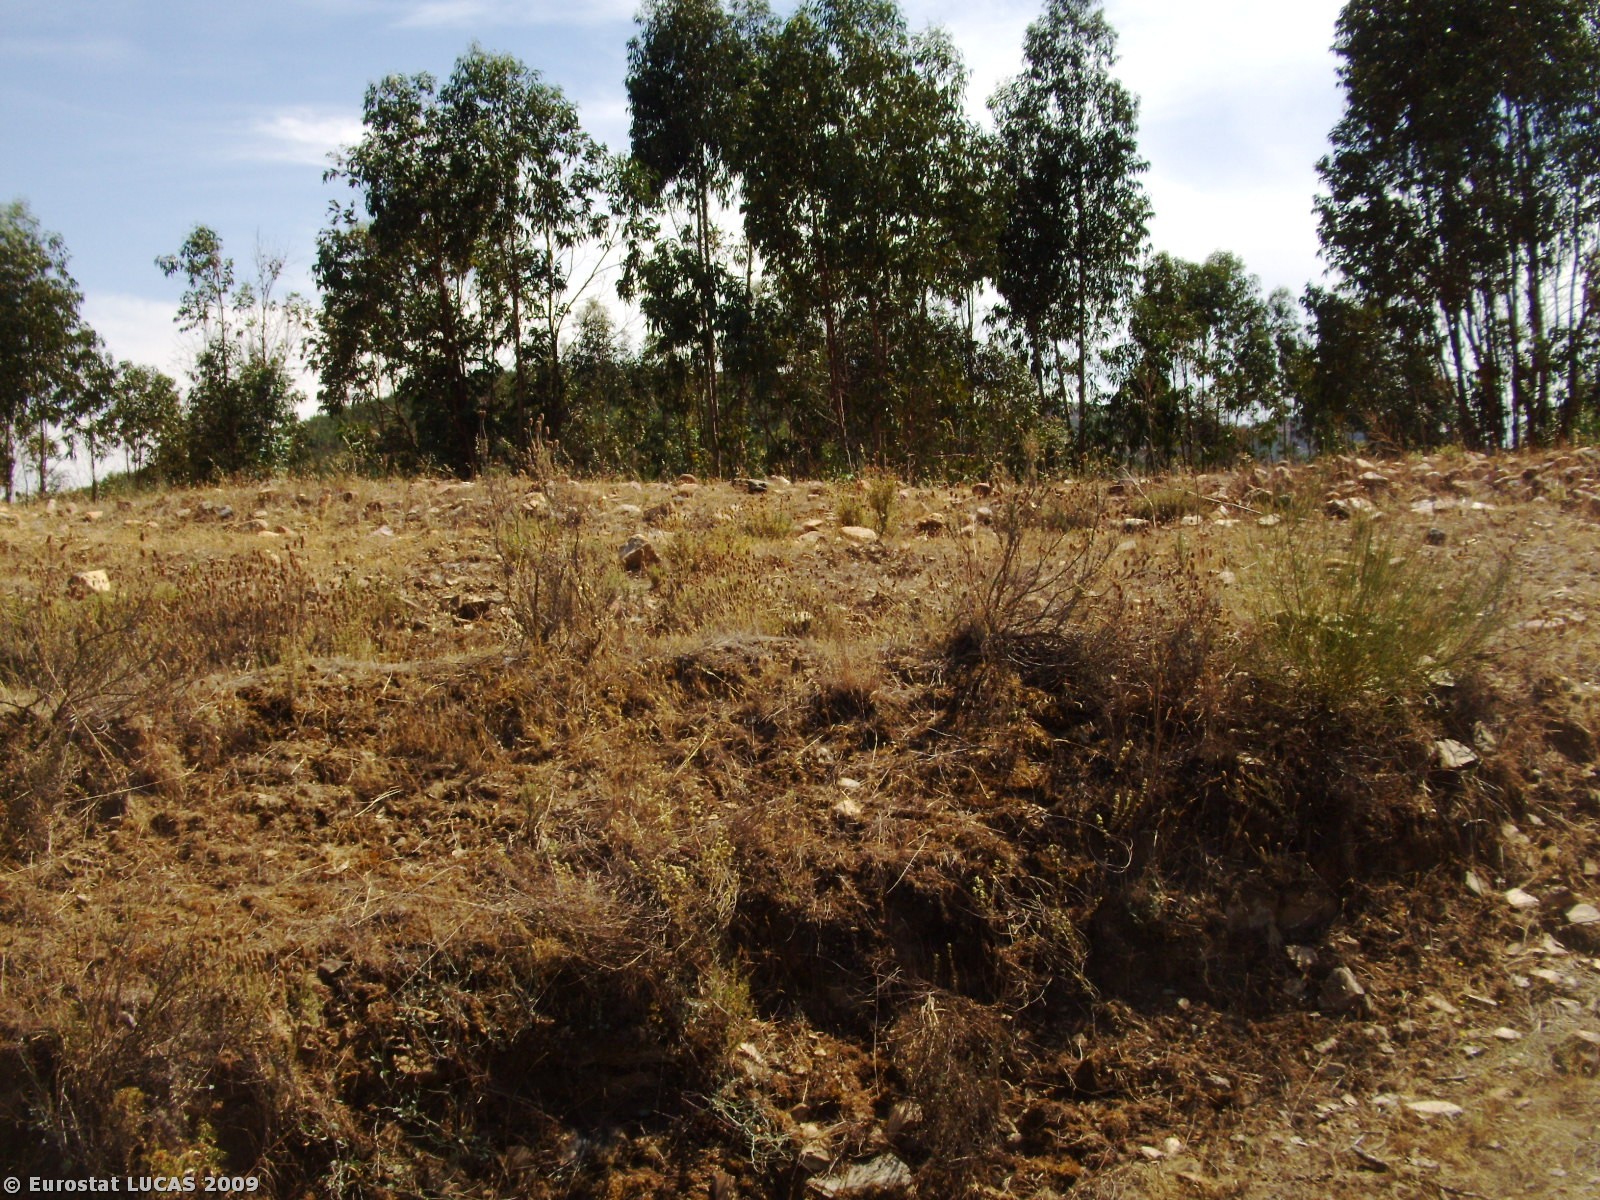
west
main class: Shrubland
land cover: Shrubland with sparse tree cover
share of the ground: 50 - 75 %
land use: Unused
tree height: > 5 m
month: July
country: PT
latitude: 40.0278
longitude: -6.8802
